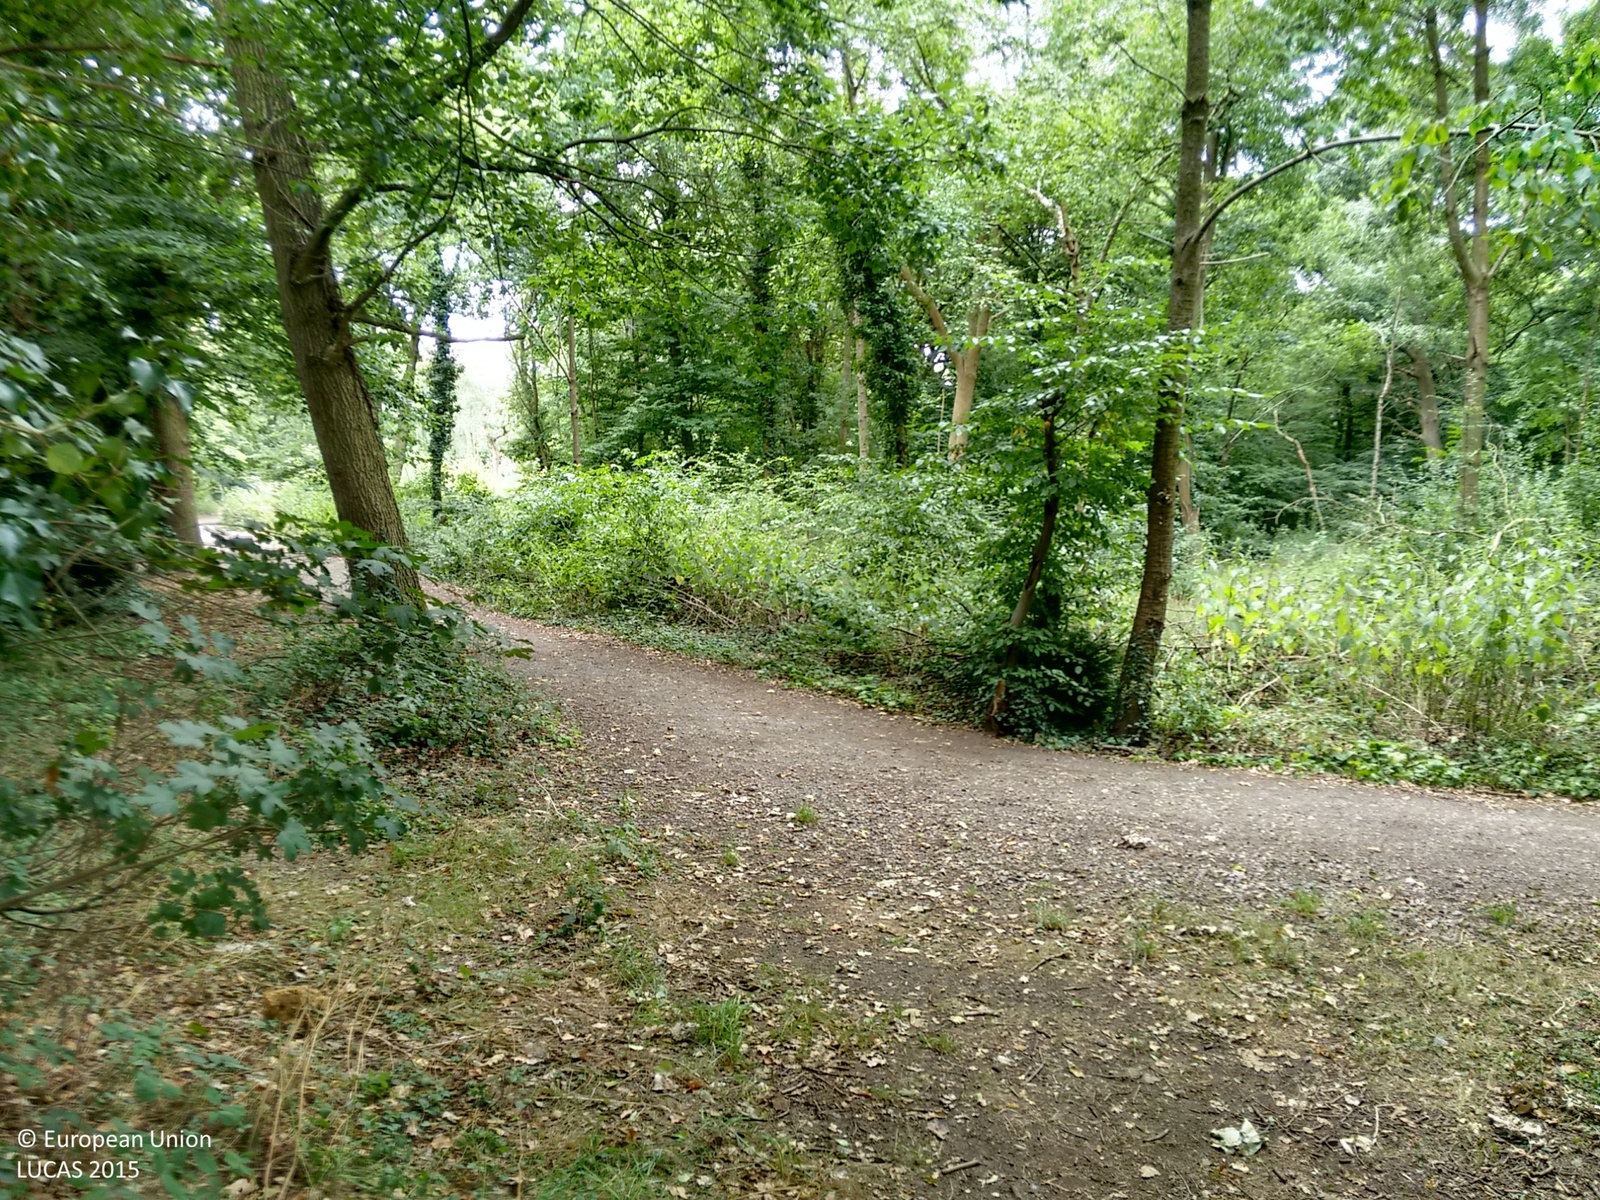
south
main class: Woodland
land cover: Broadleaved woodland
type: mesophytic deciduous forest
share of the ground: 50 - 75 %
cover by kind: broadleaved forest trees 60 %, herbaceous plants 30 %, shrubs 10 %
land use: Semi-natural and natural areas not in use
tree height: > 5 m
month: July
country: GB
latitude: 51.5916
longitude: -0.4158
